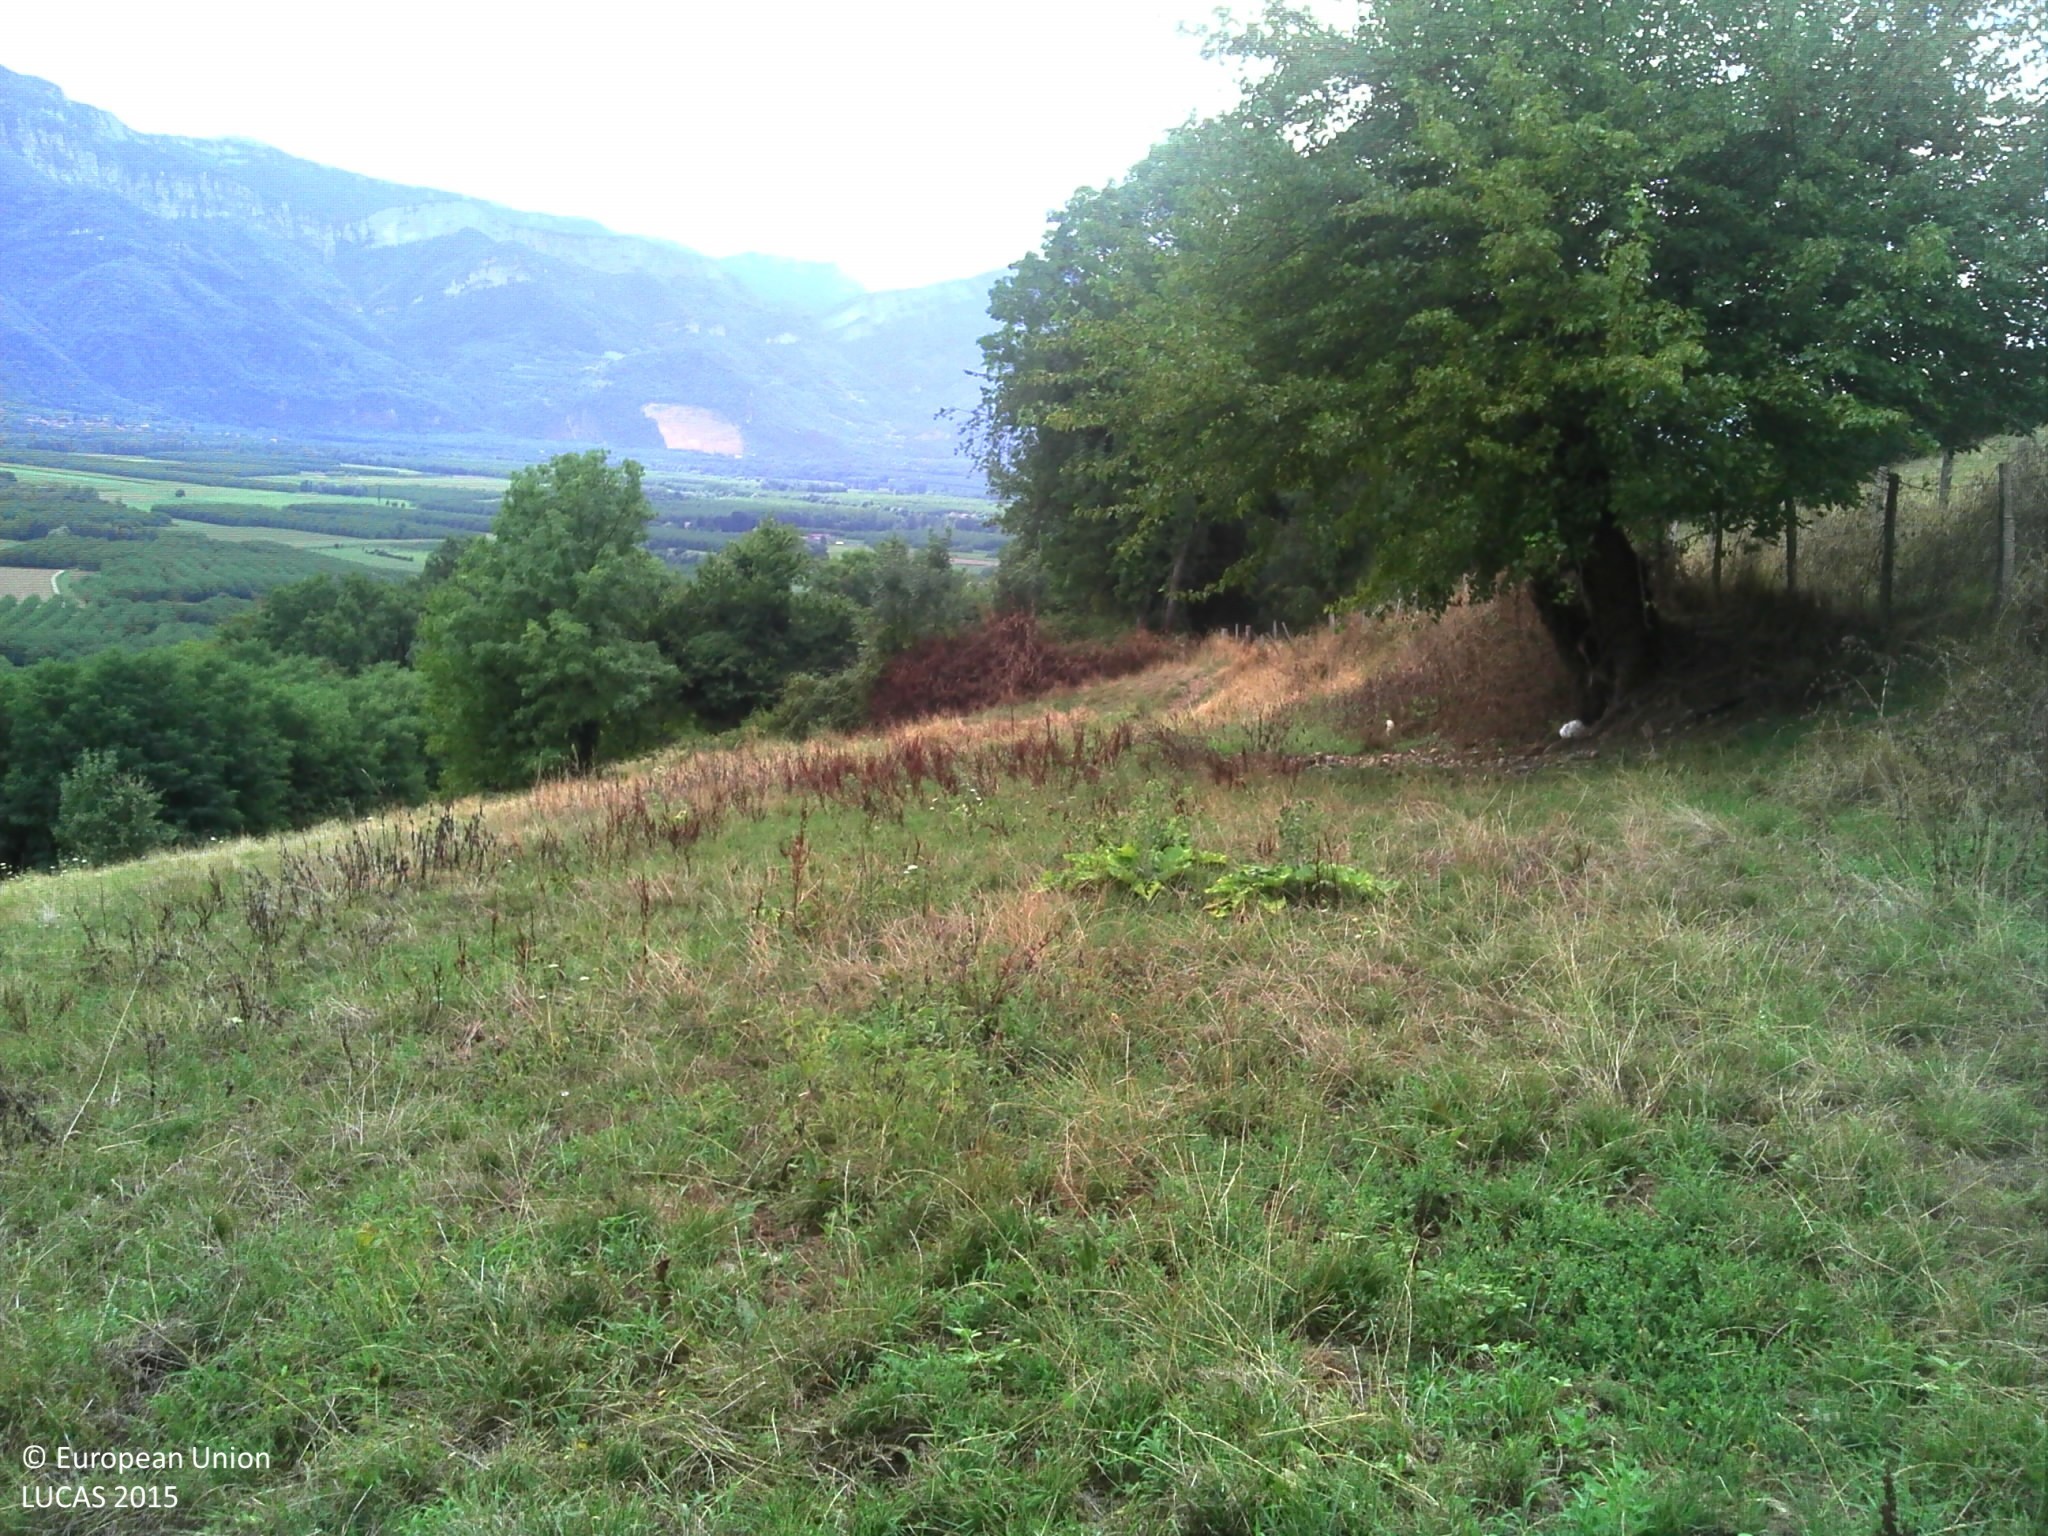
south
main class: Grassland
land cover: Grassland without tree/shrub cover
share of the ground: > 75 %
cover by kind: herbaceous plants 95 %, shrubs 5 %
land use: Agriculture (excluding fallow land and kitchen gardens)
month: August
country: FR
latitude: 45.2813
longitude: 5.4795
